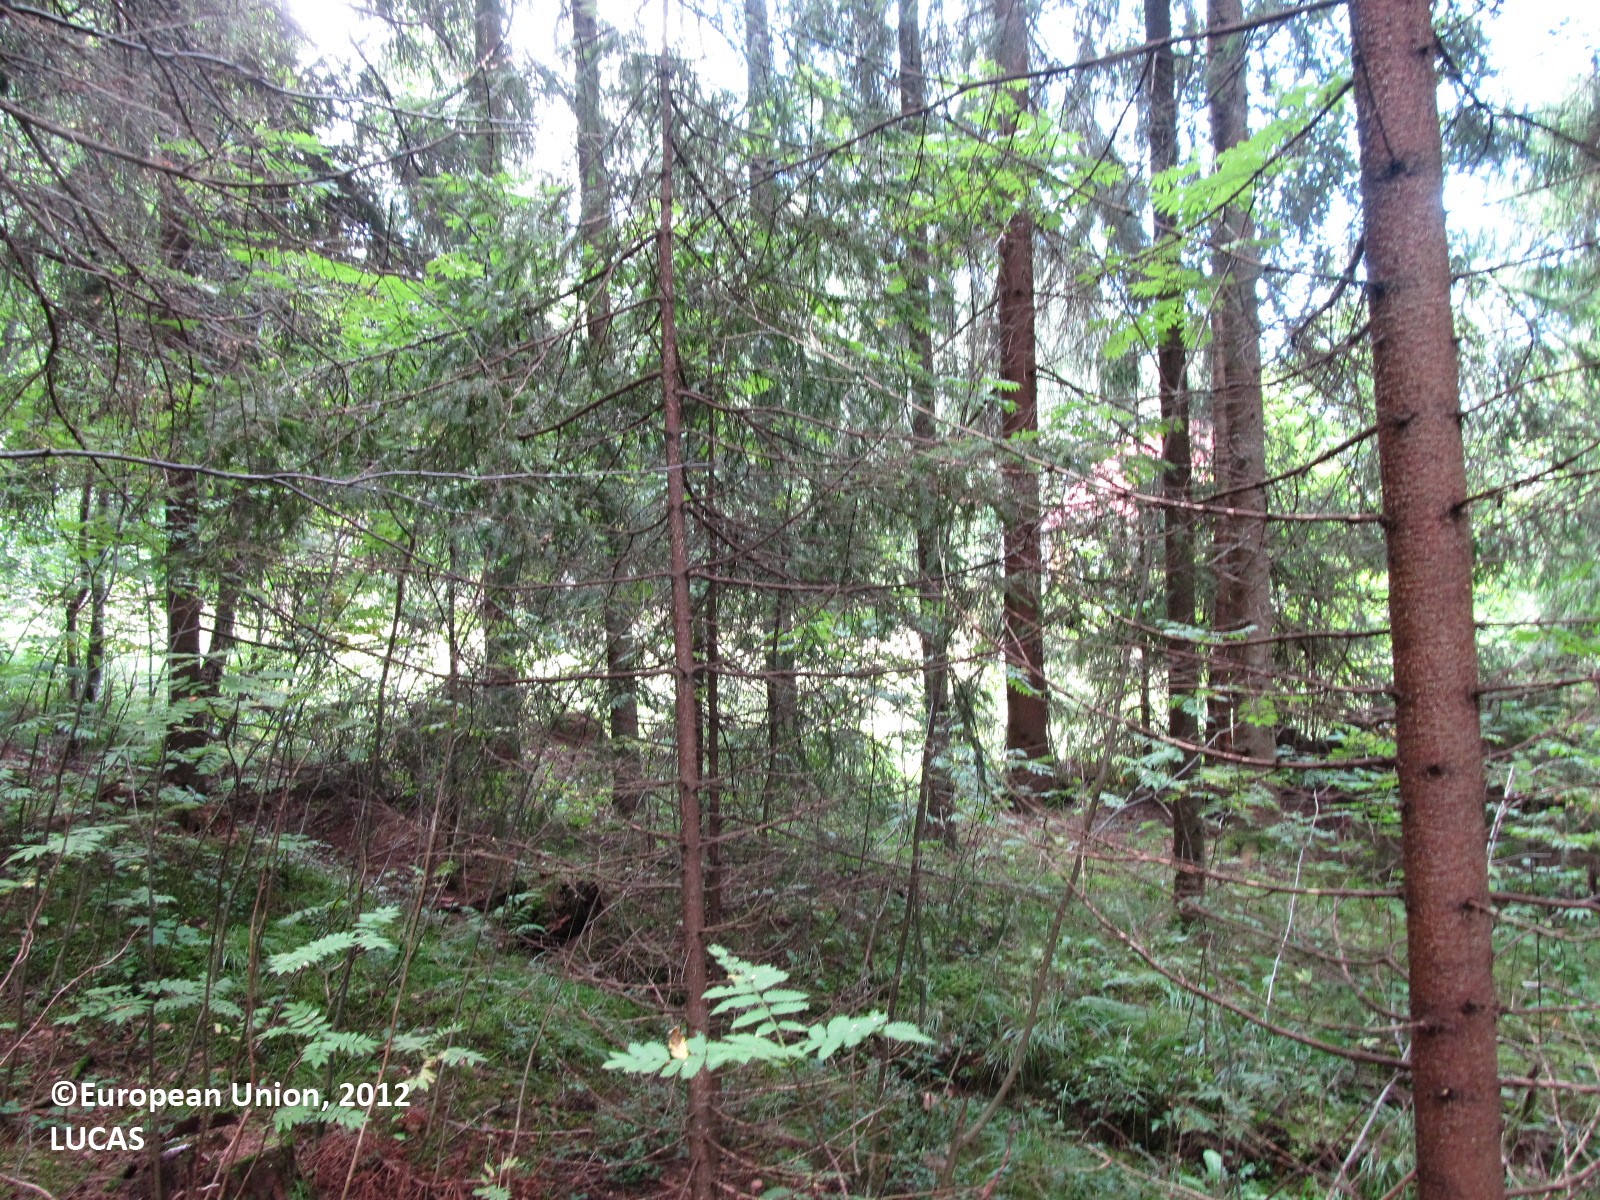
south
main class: Woodland
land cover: Spruce dominated coniferous woodland
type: boreal forest
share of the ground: 25 - 50 %
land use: Forestry
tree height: > 5 m
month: August
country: FI
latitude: 62.8877
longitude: 27.8562
